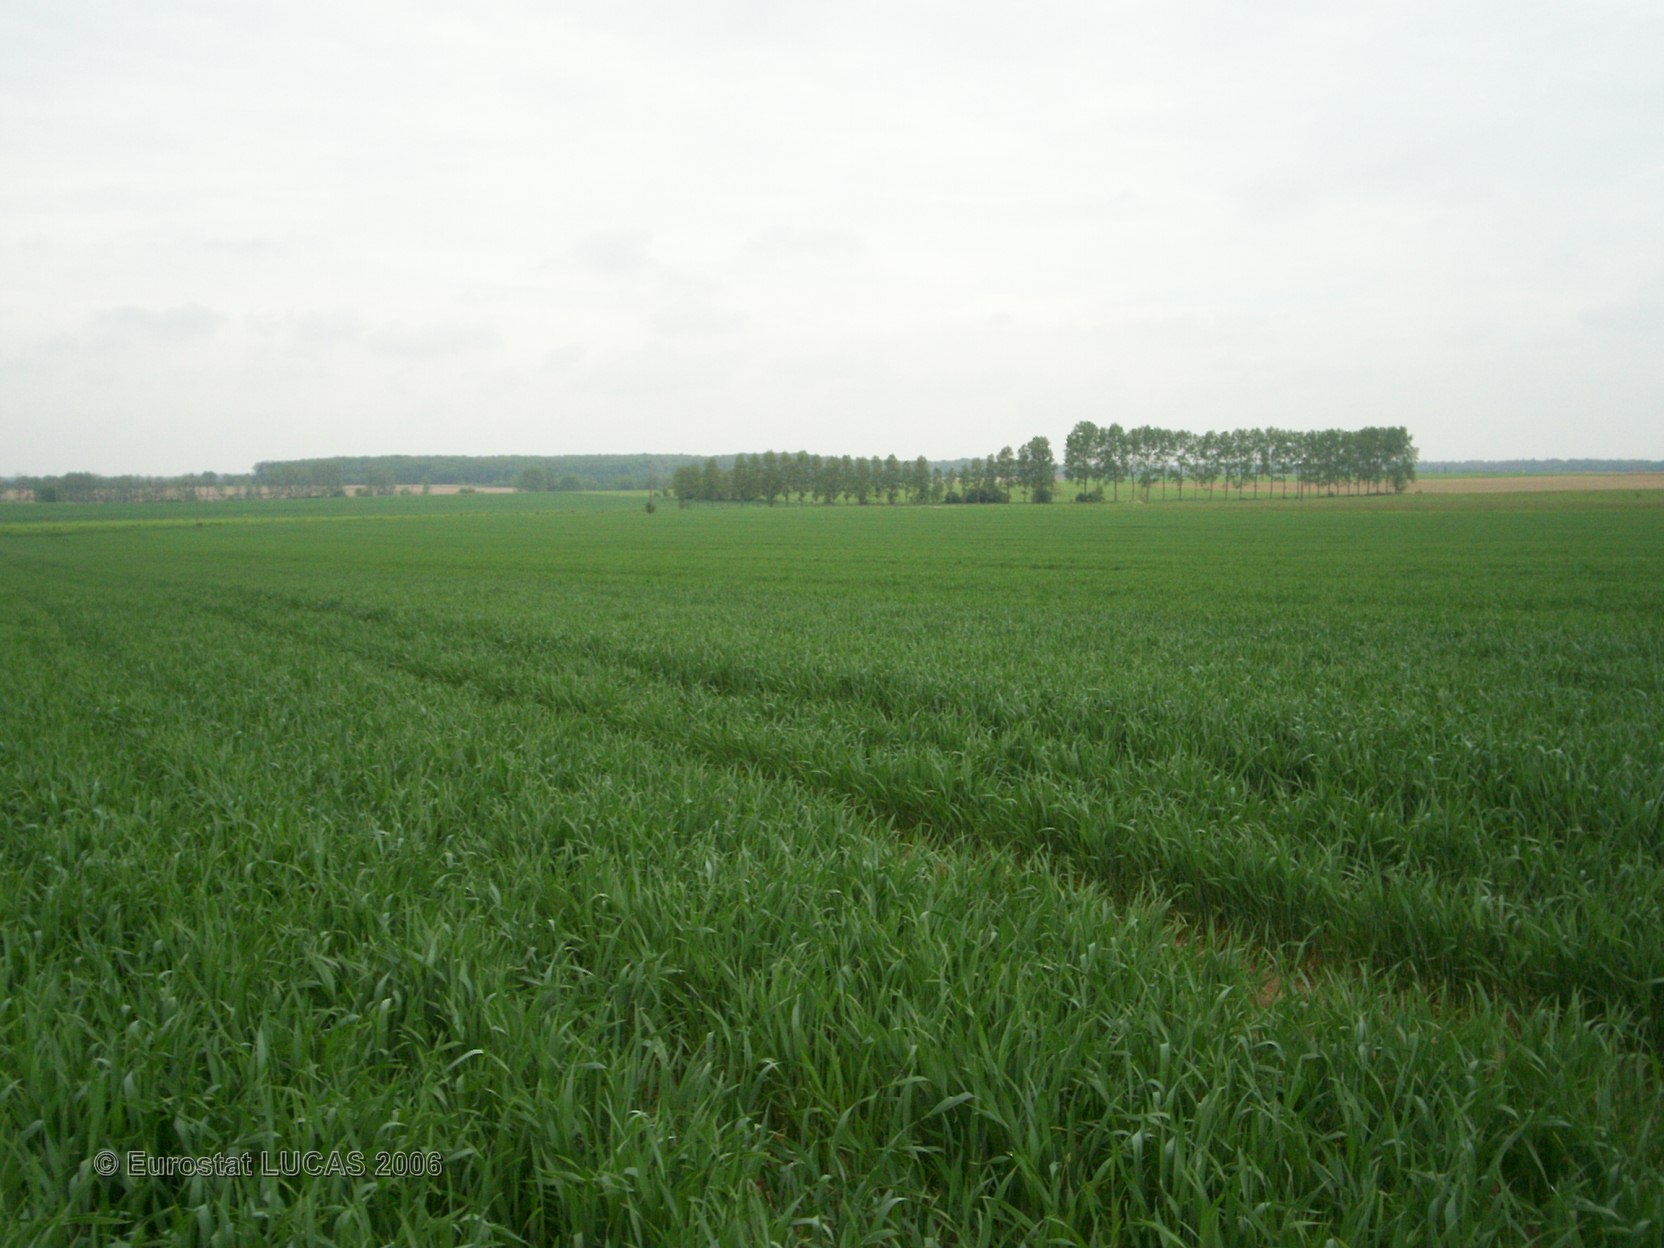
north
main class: Cropland
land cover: Common wheat
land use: Agriculture (excluding fallow land and kitchen gardens)
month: May
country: FR
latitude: 46.7942
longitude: -1.0519
